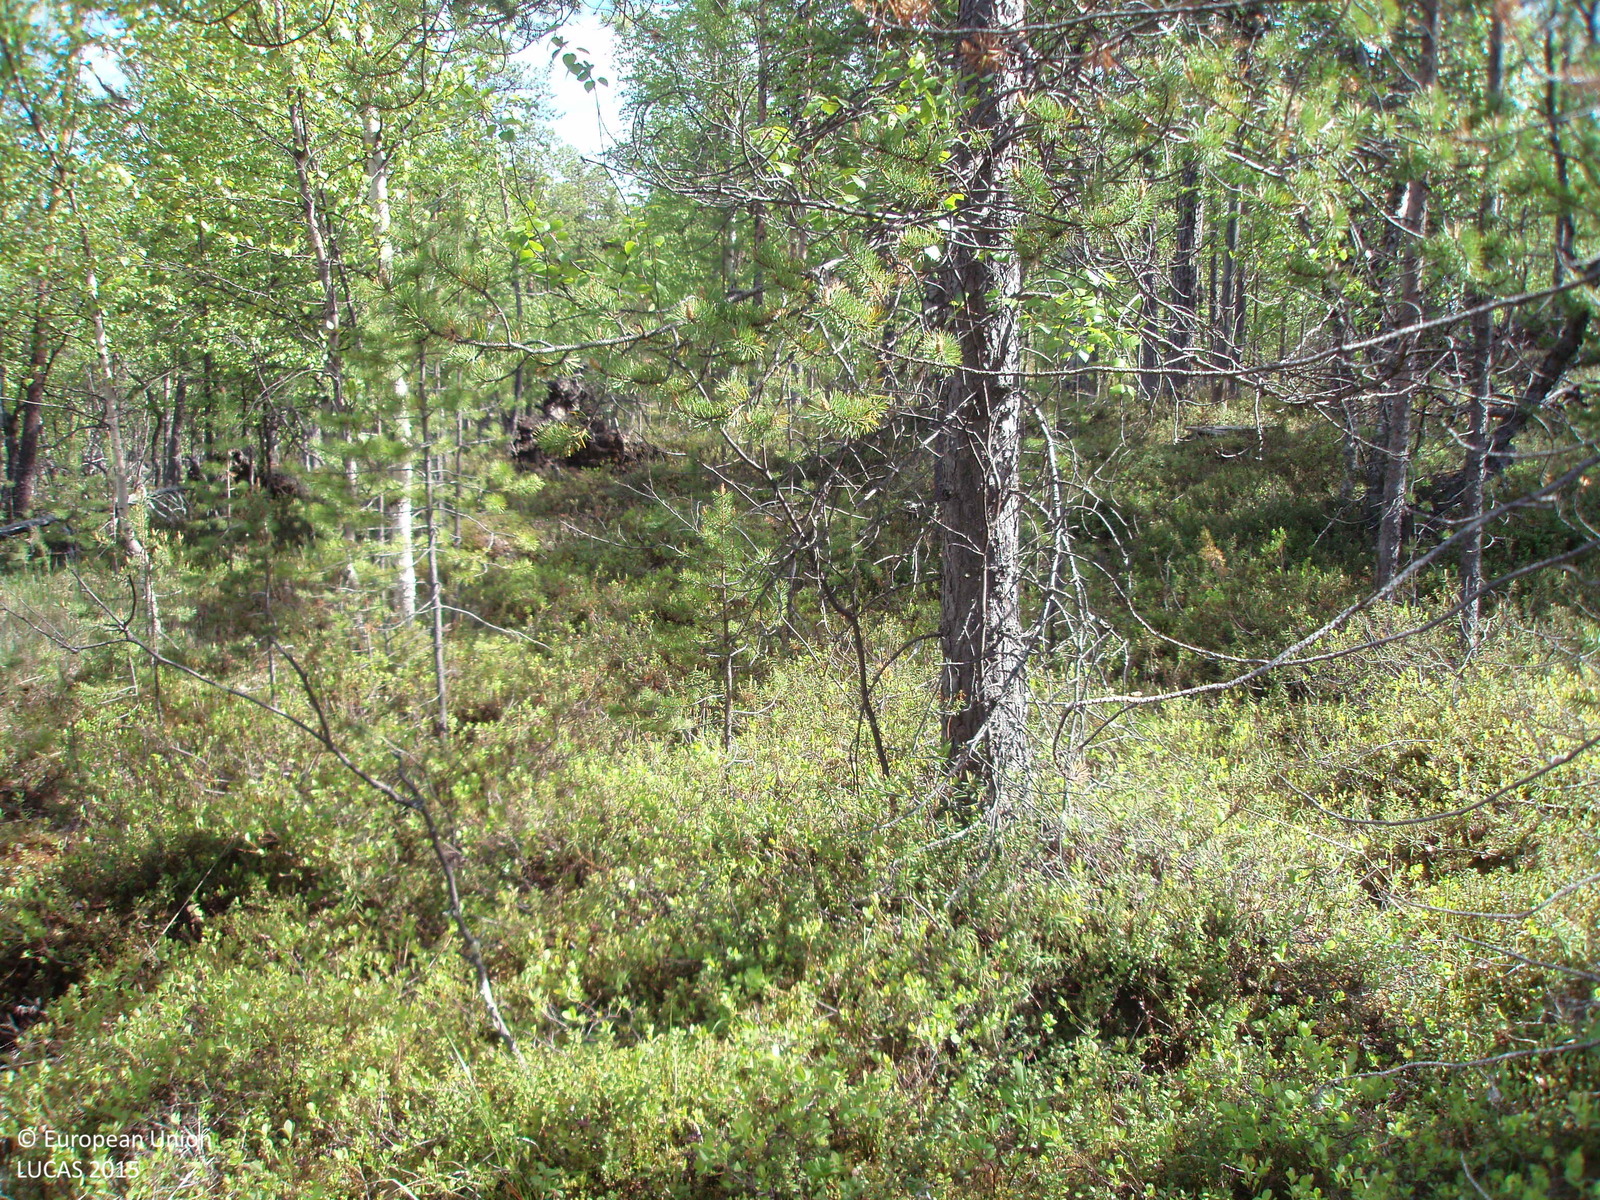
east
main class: Woodland
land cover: Pine dominated mixed woodland
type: boreal forest
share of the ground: 50 - 75 %
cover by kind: broadleaved forest trees 40 %, coniferous forest trees 30 %, shrubs 20 %, herbaceous plants 5 %, lichens and mosses 5 %
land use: Forestry
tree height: > 5 m
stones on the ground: 25 - 50 %
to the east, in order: Pine dominated mixed woodland; Other bare soil; Ditches and canals; Rock outcrops; Tracks; Grass margins; Ditches and canals; Shrubland with sparse tree cover; Pine dominated coniferous woodland; Pine dominated mixed woodland
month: June
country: FI
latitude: 68.7707
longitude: 28.0821
